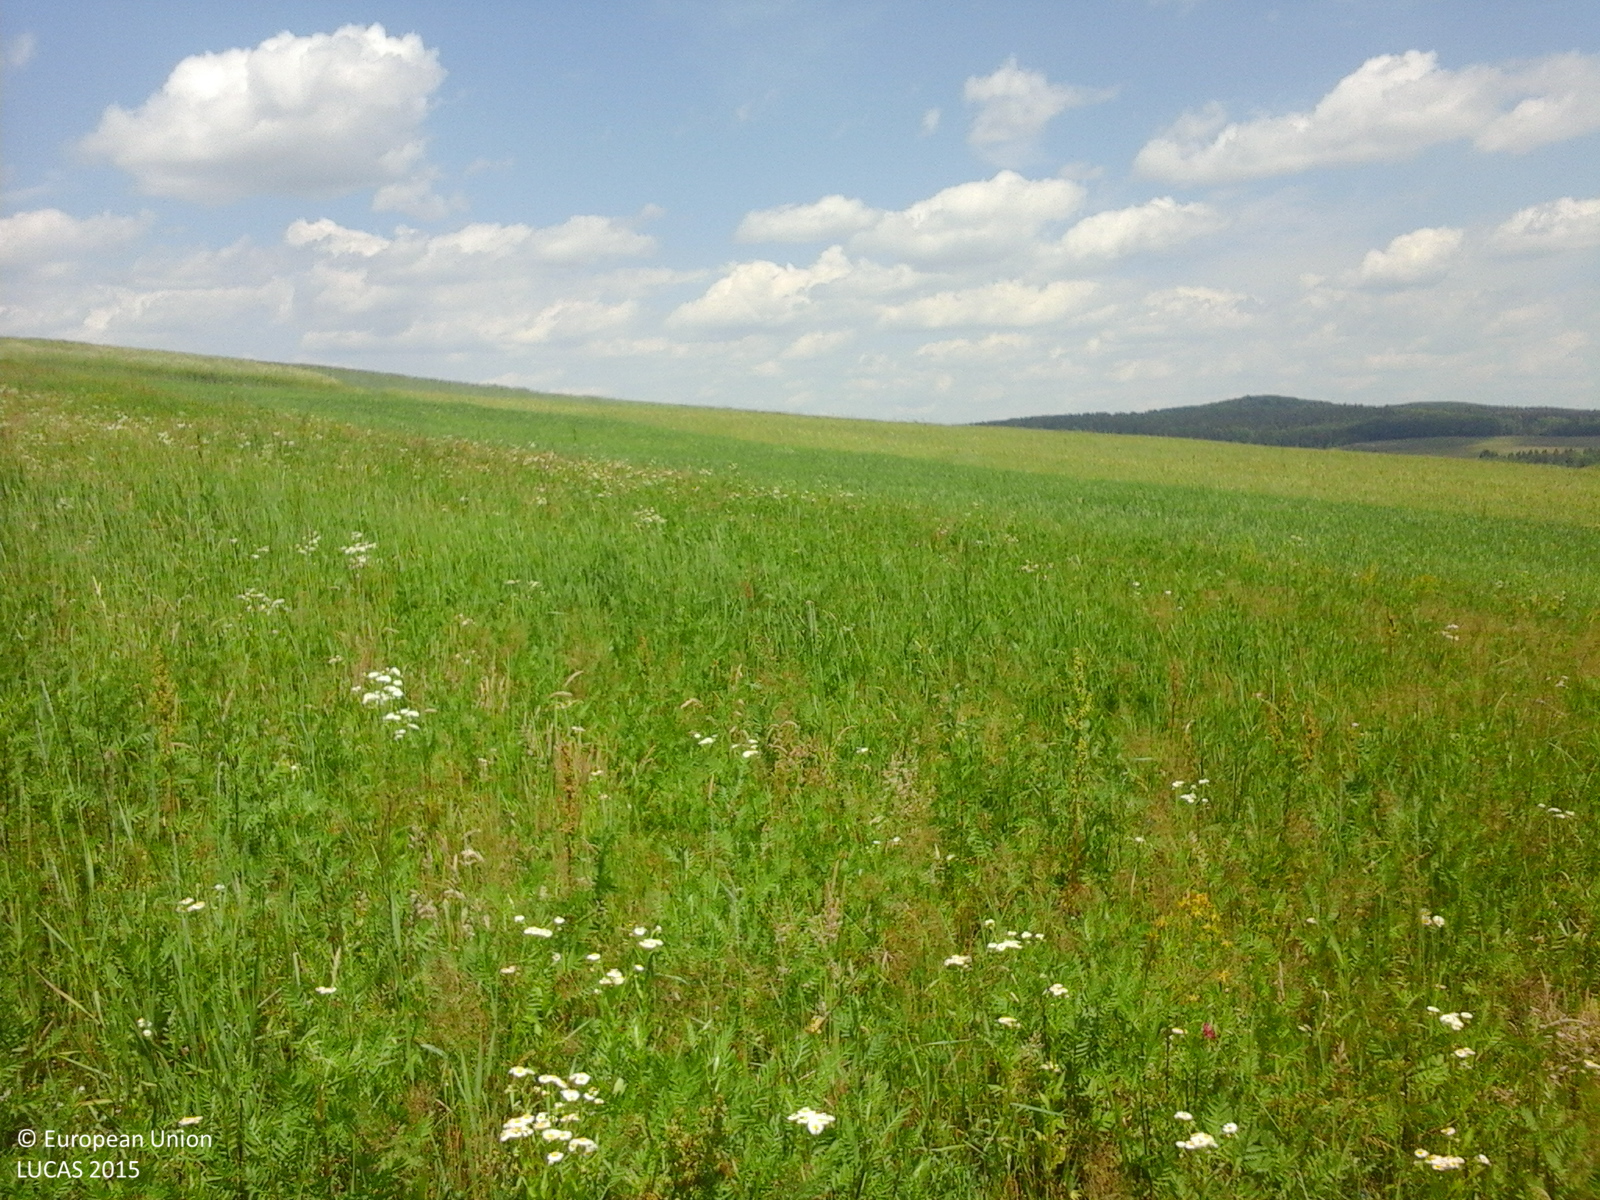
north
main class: Grassland
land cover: Grassland without tree/shrub cover
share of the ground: > 75 %
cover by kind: herbaceous plants 100 %
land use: Agriculture (excluding fallow land and kitchen gardens)
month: June
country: RO
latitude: 47.7592
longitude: 25.8829
